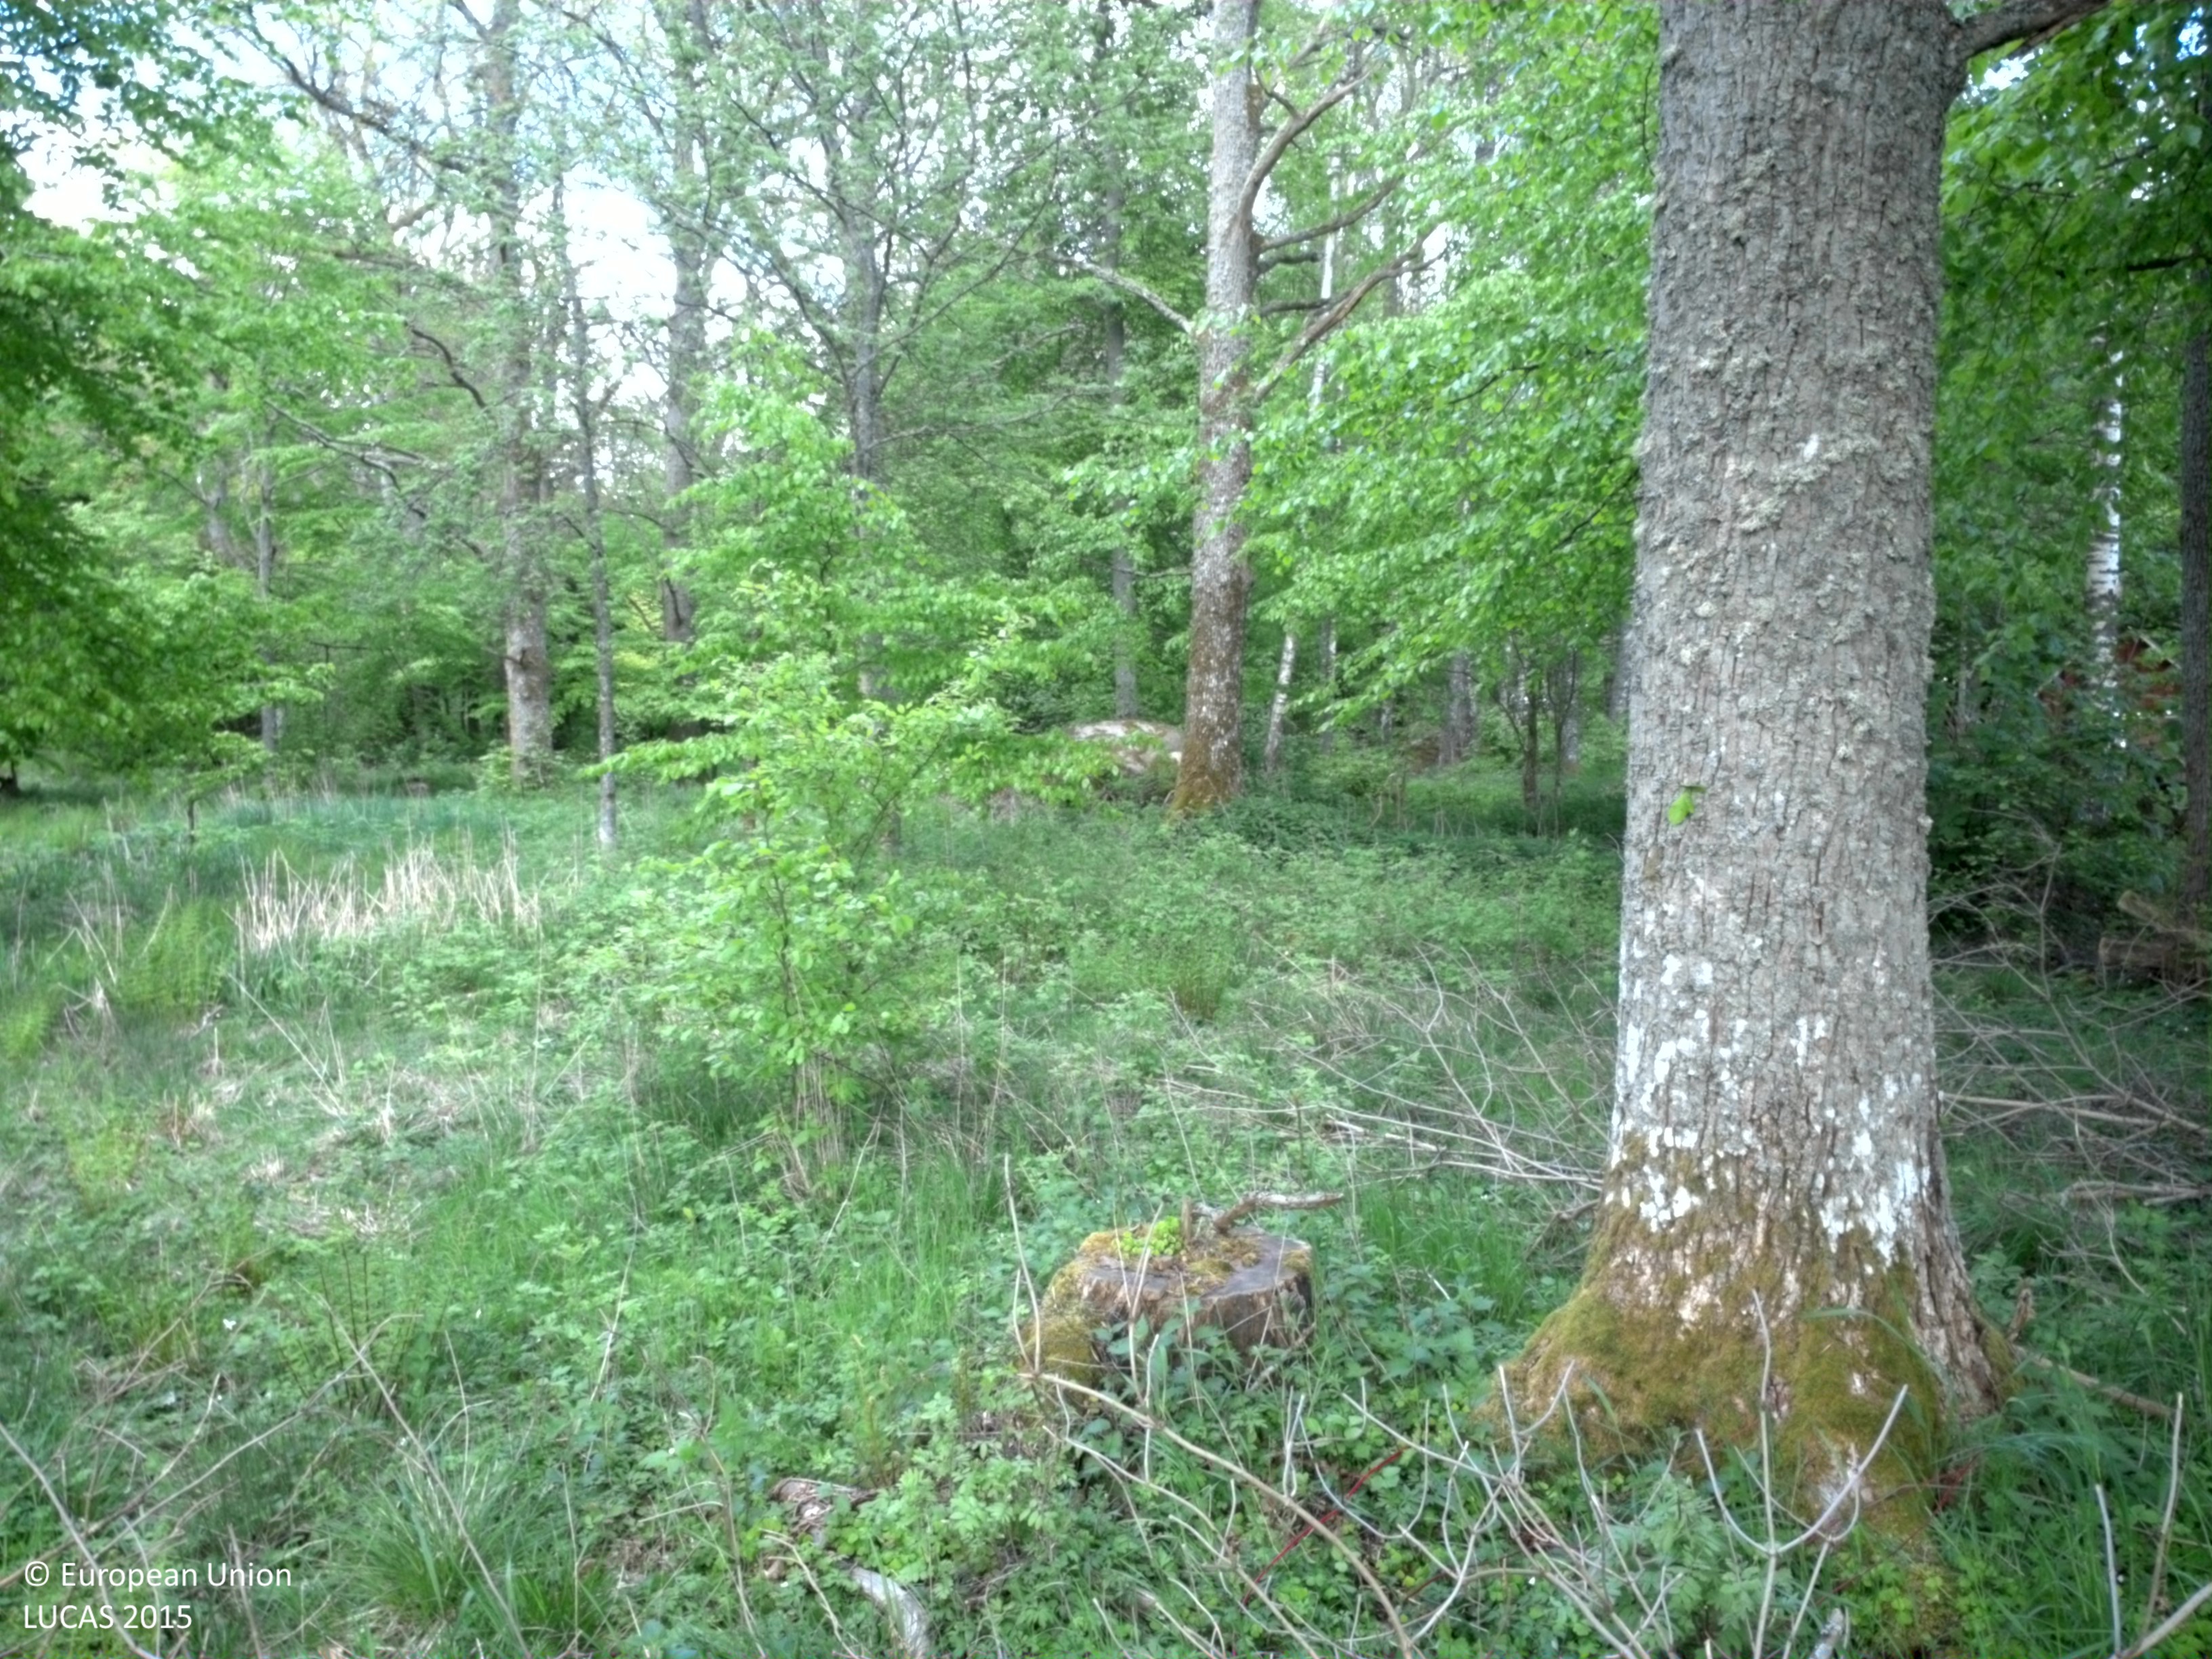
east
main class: Woodland
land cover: Broadleaved woodland
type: boreal forest
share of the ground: 50 - 75 %
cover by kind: broadleaved forest trees 60 %, herbaceous plants 30 %, coniferous forest trees 10 %
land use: Forestry
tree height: > 5 m
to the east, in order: Broadleaved woodland; Paved roads, cycling and walking lanes; Broadleaved woodland; Electric lines; Broadleaved woodland; Paved roads, cycling and walking lanes; Broadleaved woodland; Electric lines; Ditches and canals; Grassland without tree/shrub cover; Ditches and canals; Inland marshes
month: May
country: SE
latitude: 56.6990
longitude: 14.6189
